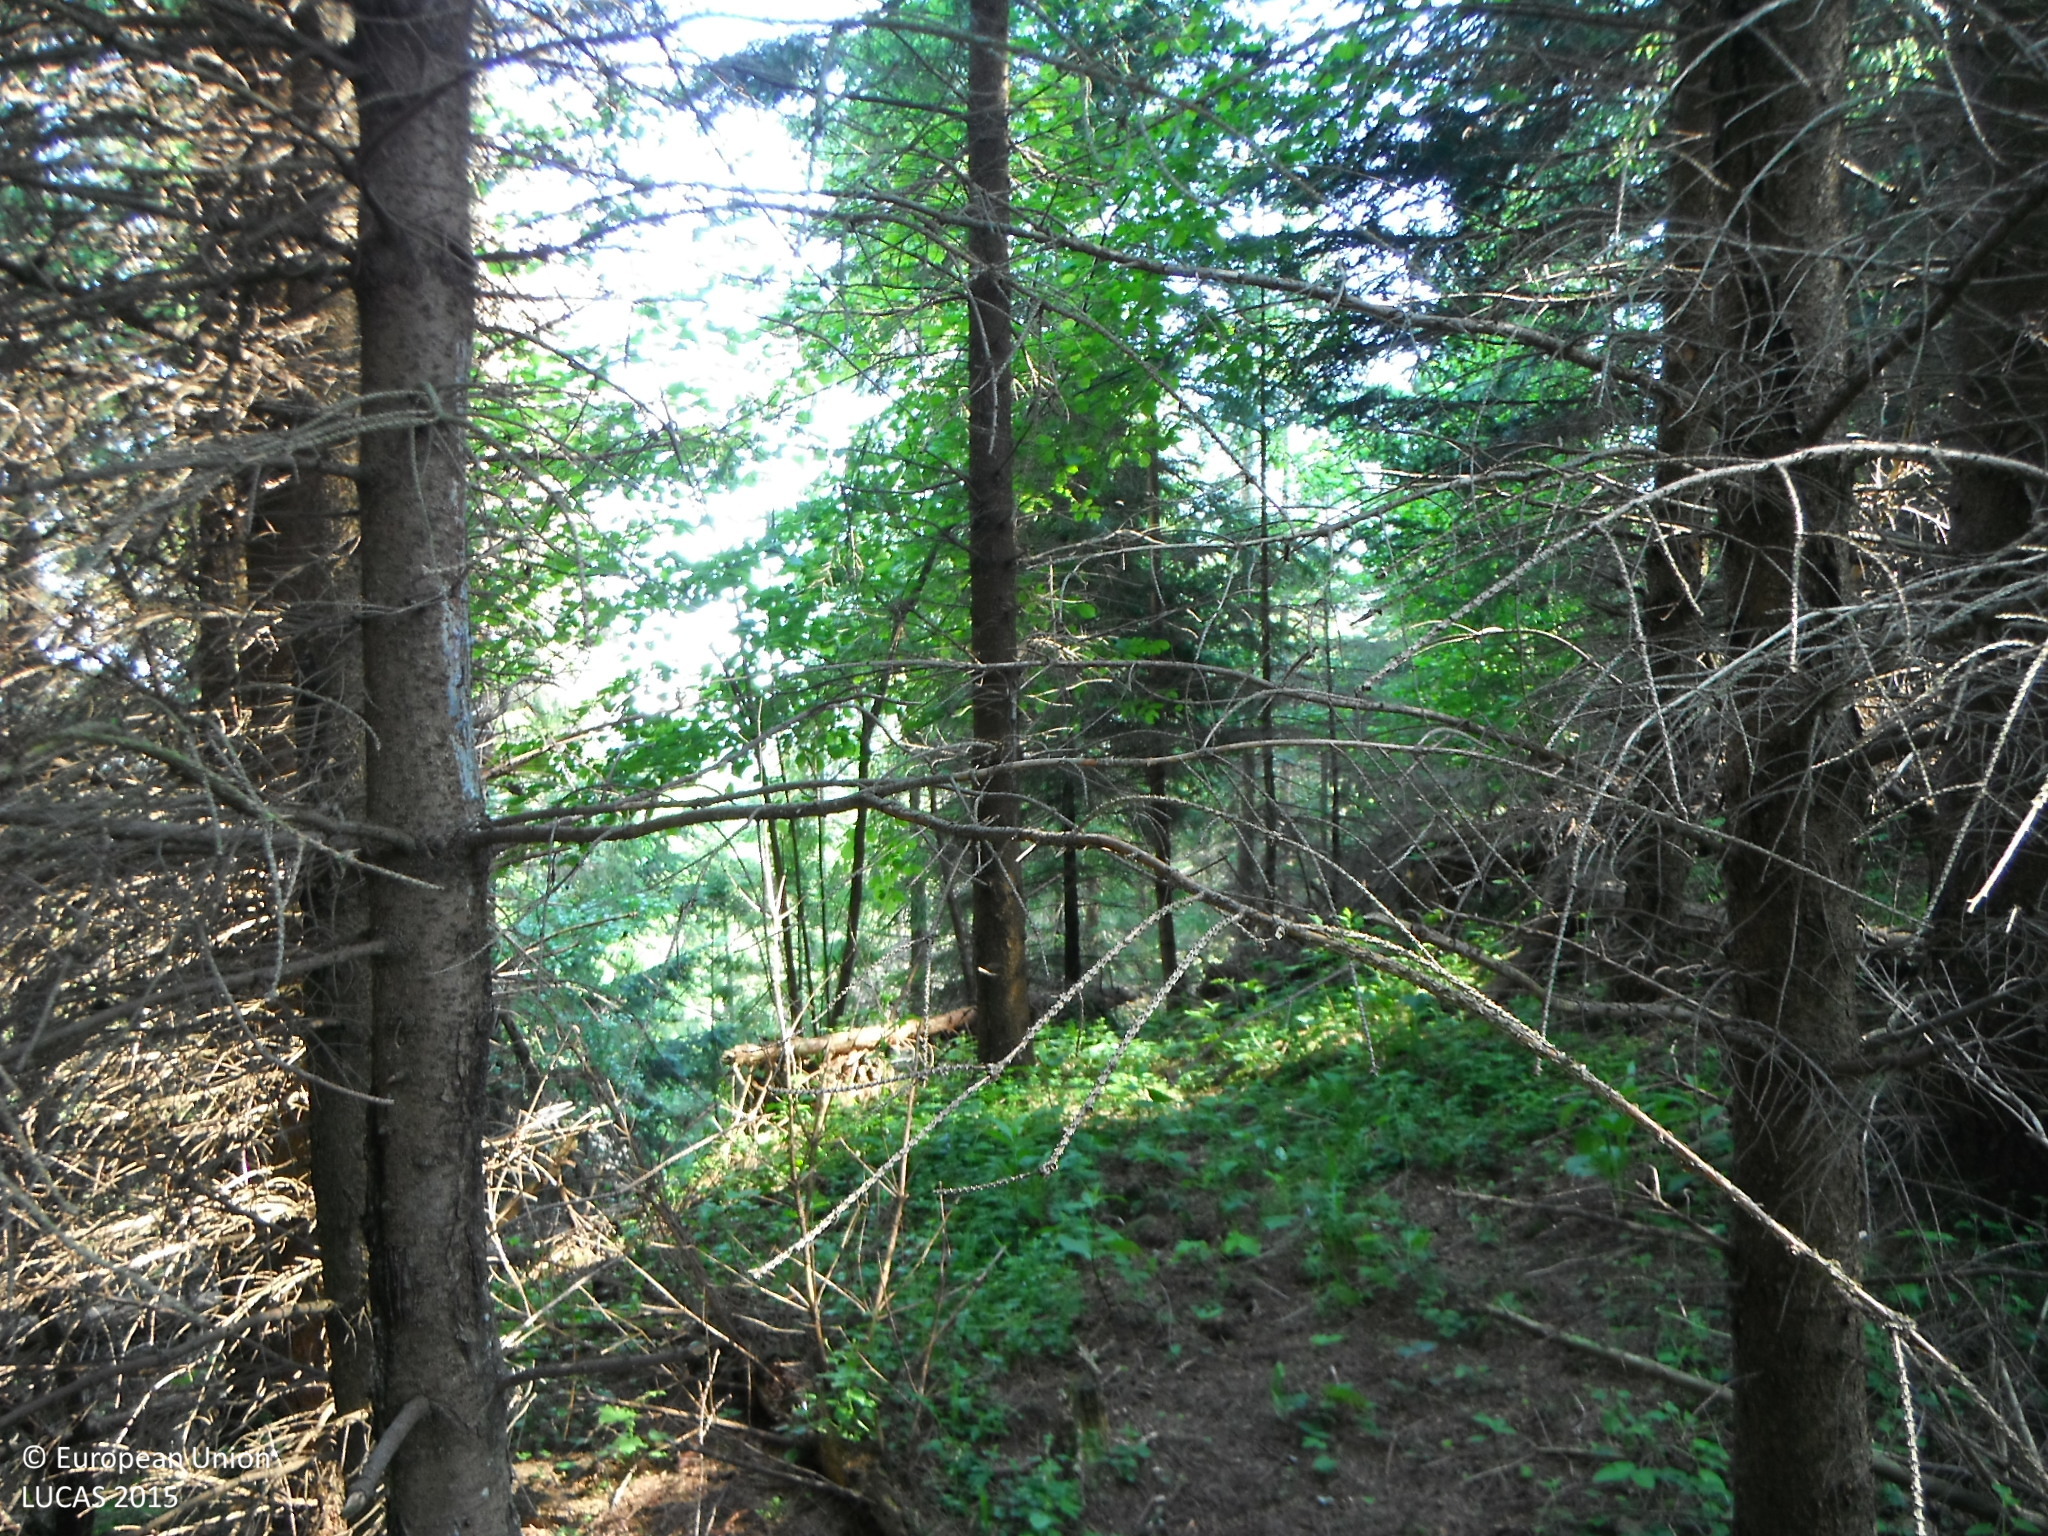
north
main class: Woodland
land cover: Spruce dominated coniferous woodland
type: alpine coniferous forest
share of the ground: > 75 %
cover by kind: coniferous forest trees 100 %
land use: Forestry
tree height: > 5 m
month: June
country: SK
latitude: 49.2551
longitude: 20.7701
